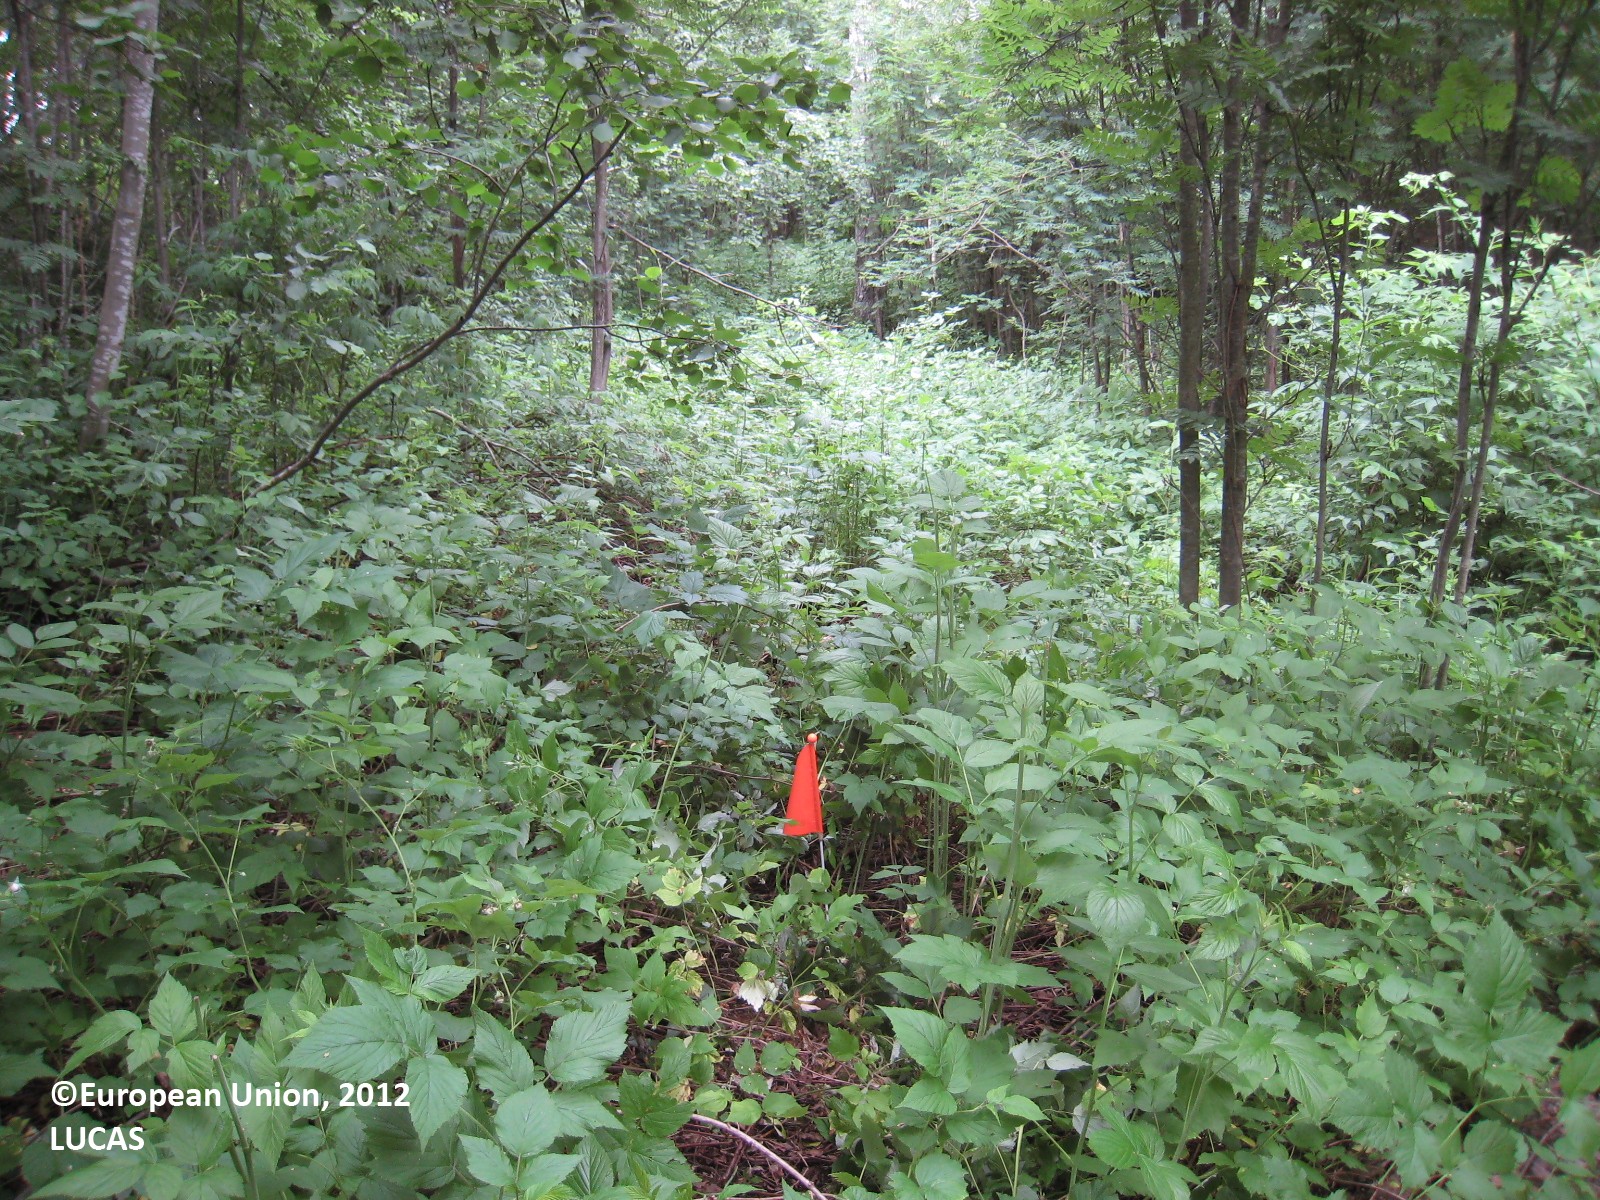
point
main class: Woodland
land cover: Broadleaved woodland
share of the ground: 50 - 75 %
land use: Semi-natural and natural areas not in use
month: July
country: FI
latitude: 61.8242
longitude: 27.1155
